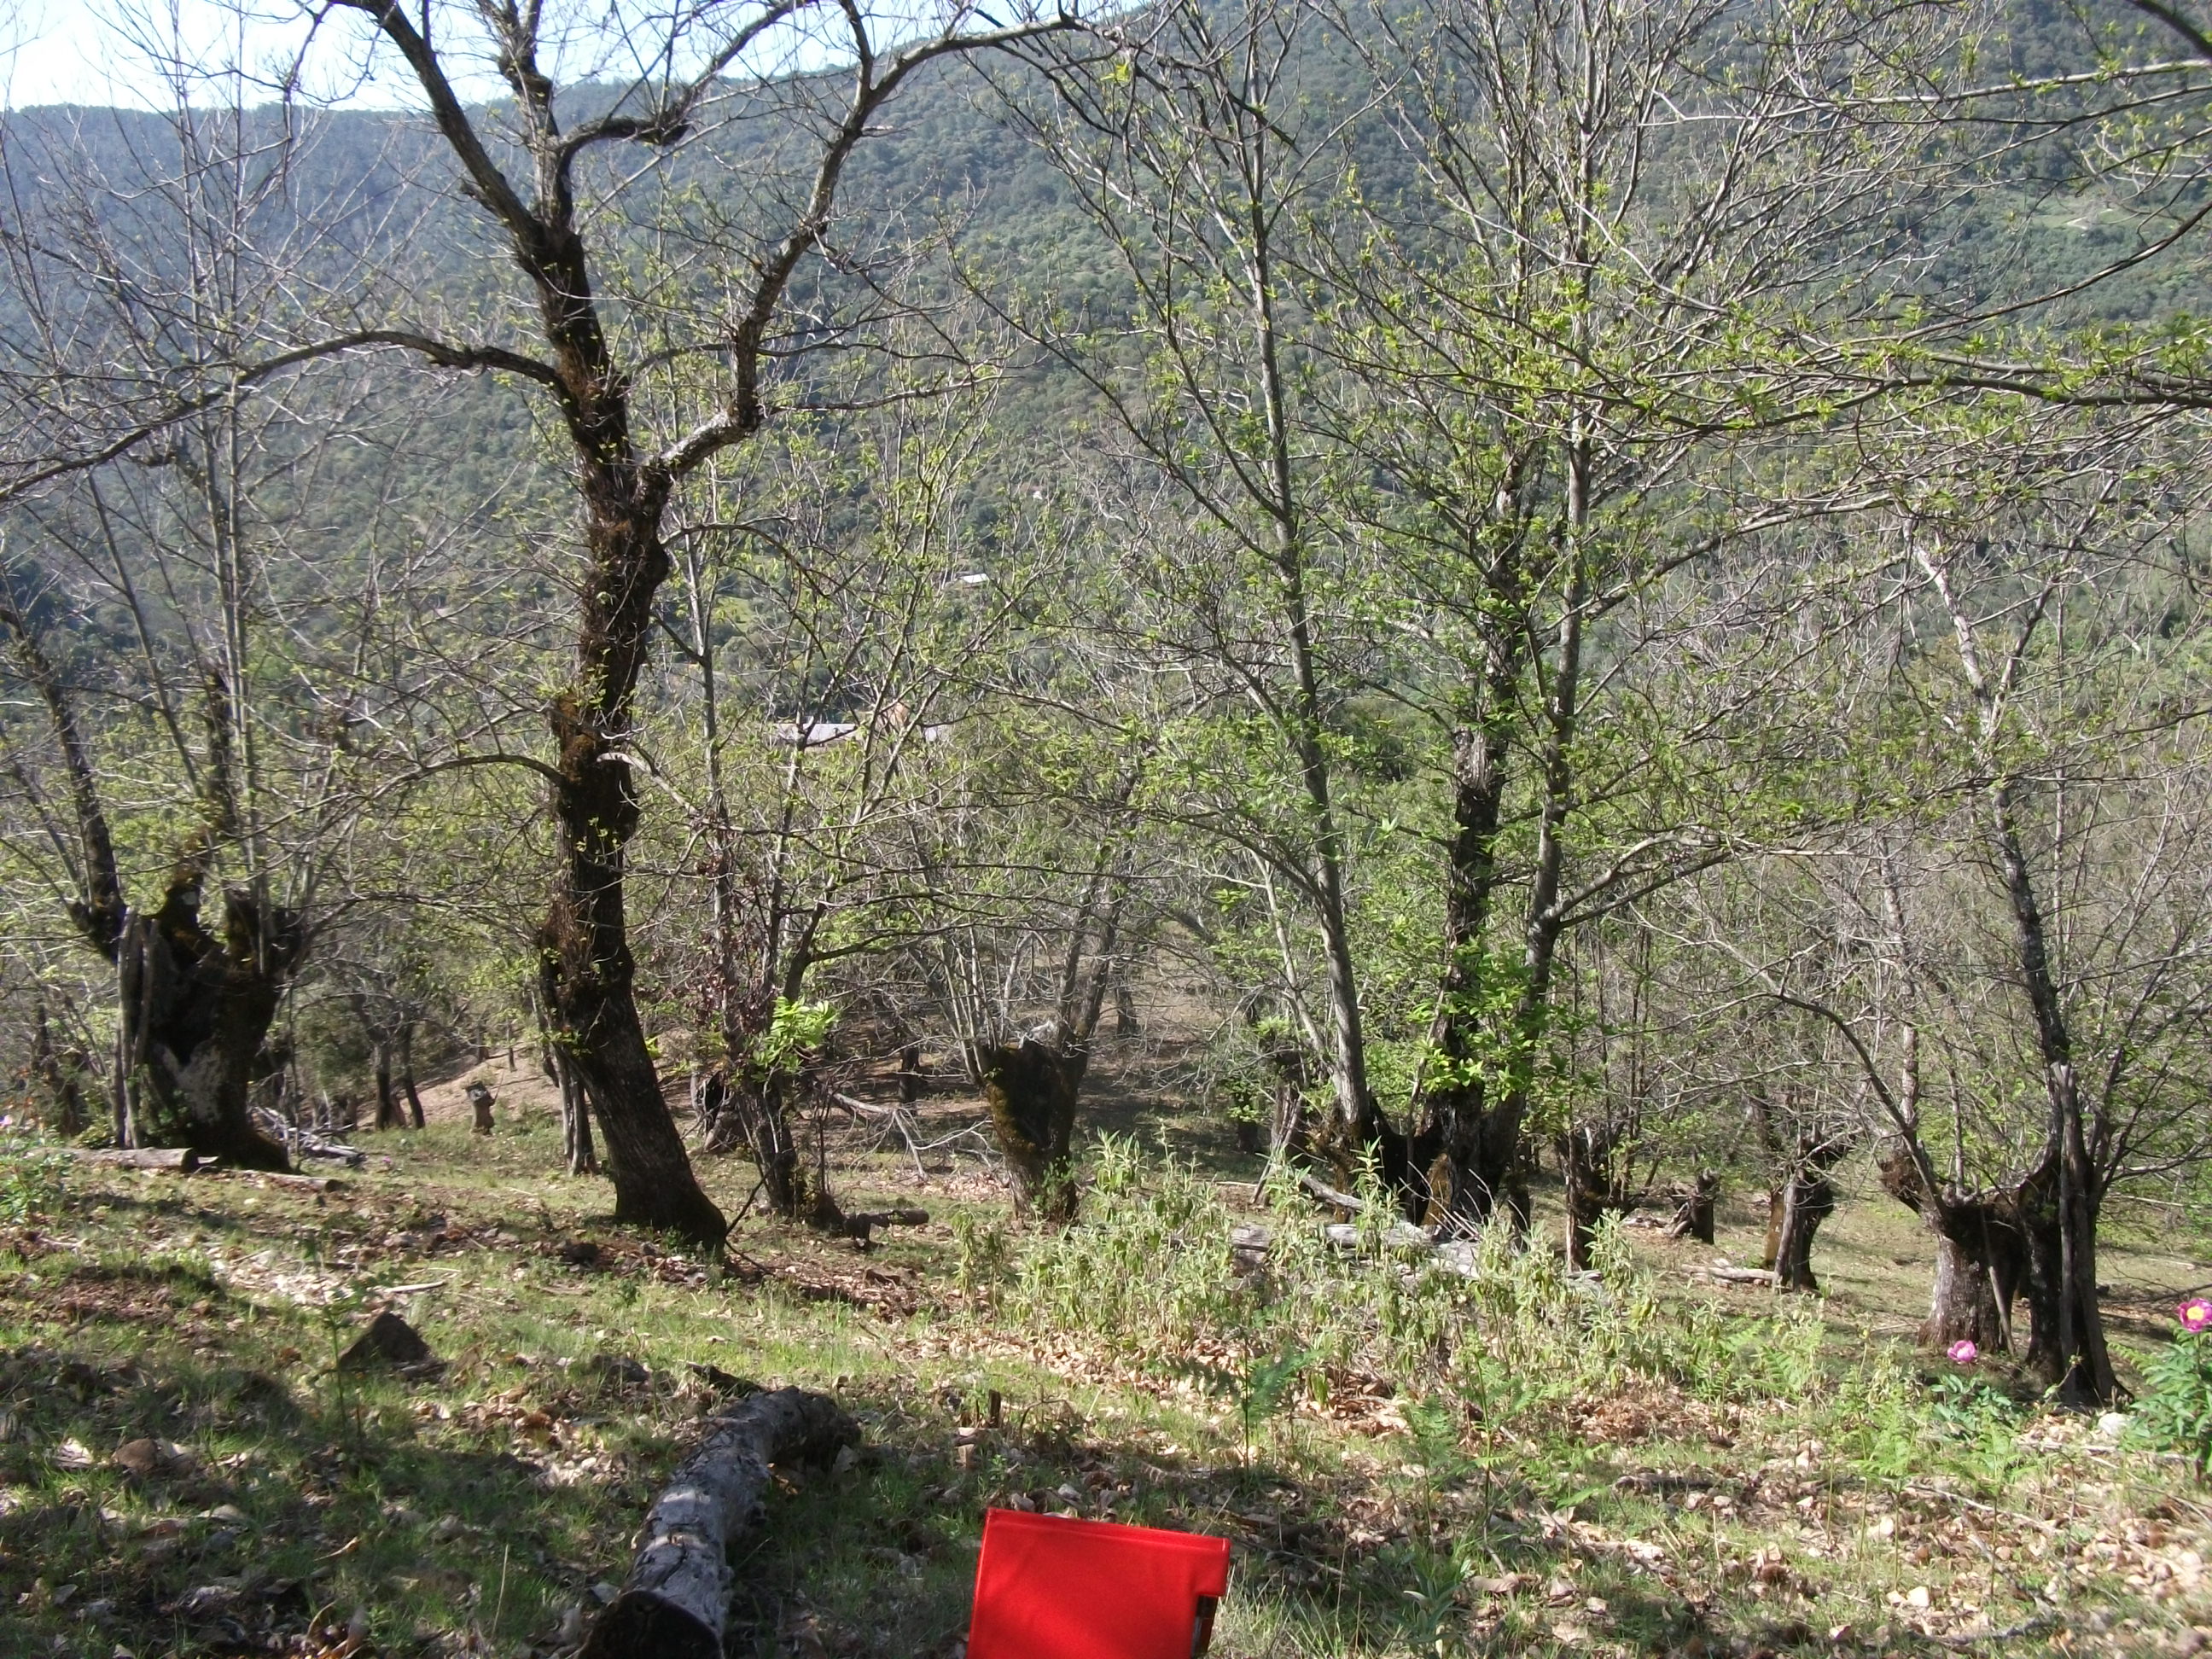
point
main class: Cropland
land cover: Nuts trees
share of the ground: 50 - 75 %
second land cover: Spontaneously vegetated surfaces
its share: > 75 %
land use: Agriculture (excluding fallow land and kitchen gardens)
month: April
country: ES
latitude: 37.8815
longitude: -6.6096
